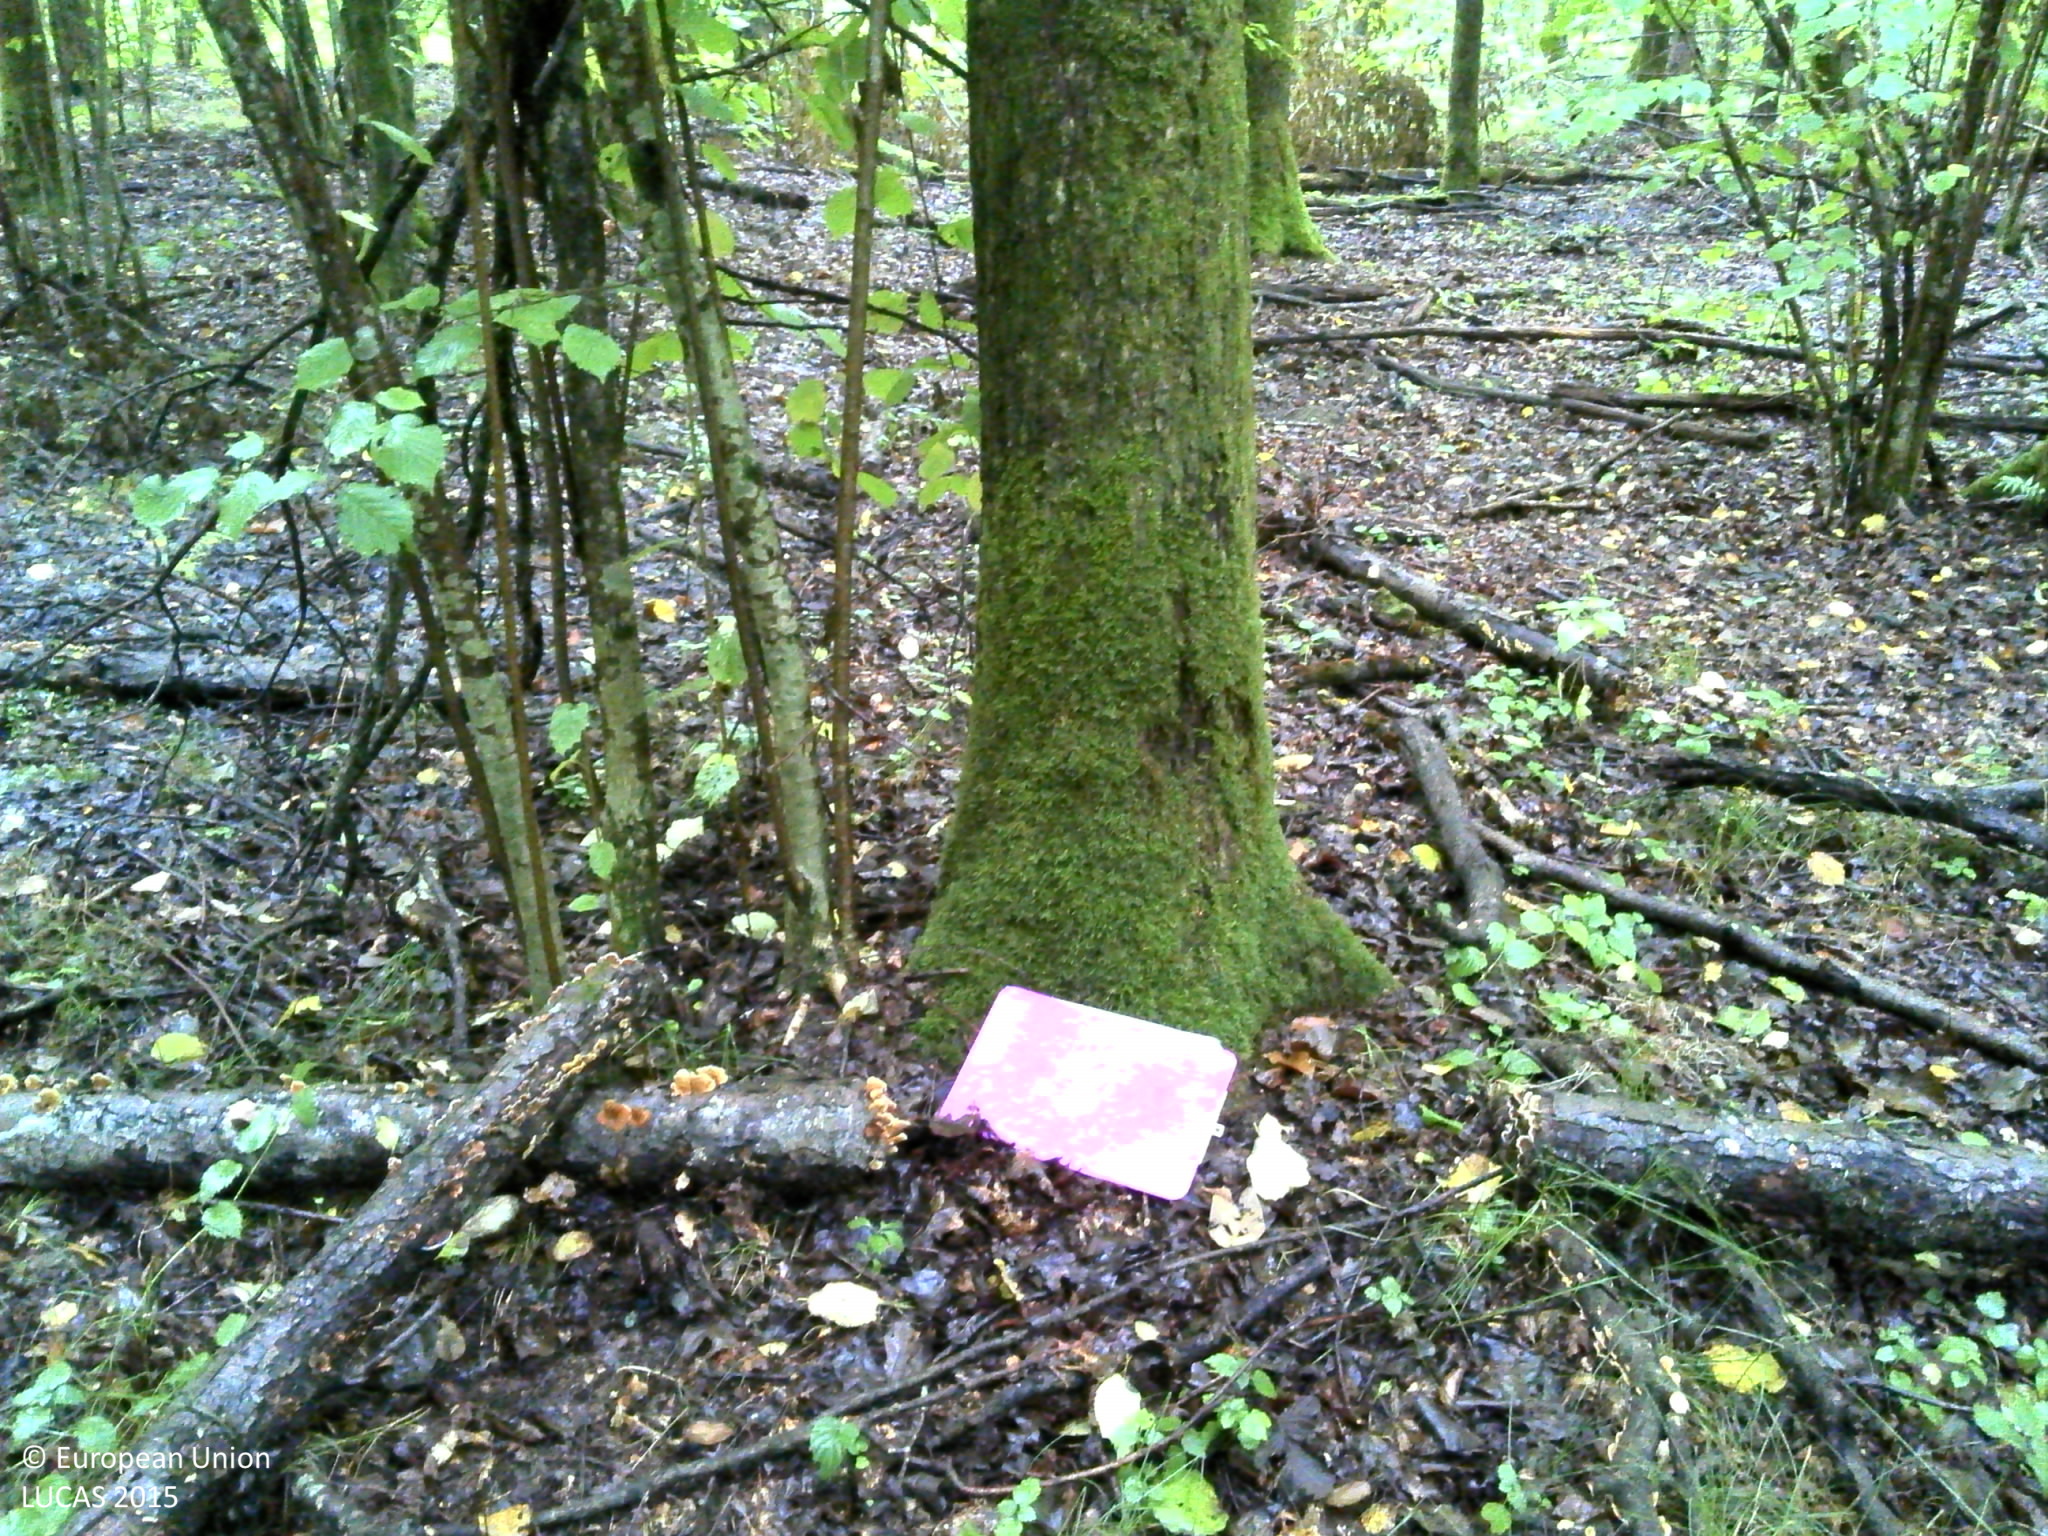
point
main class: Woodland
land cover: Broadleaved woodland
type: mesophytic deciduous forest
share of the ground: > 75 %
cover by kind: broadleaved forest trees 100 %
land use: Forestry
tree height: > 5 m
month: August
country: HR
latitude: 45.5700
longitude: 15.6474
